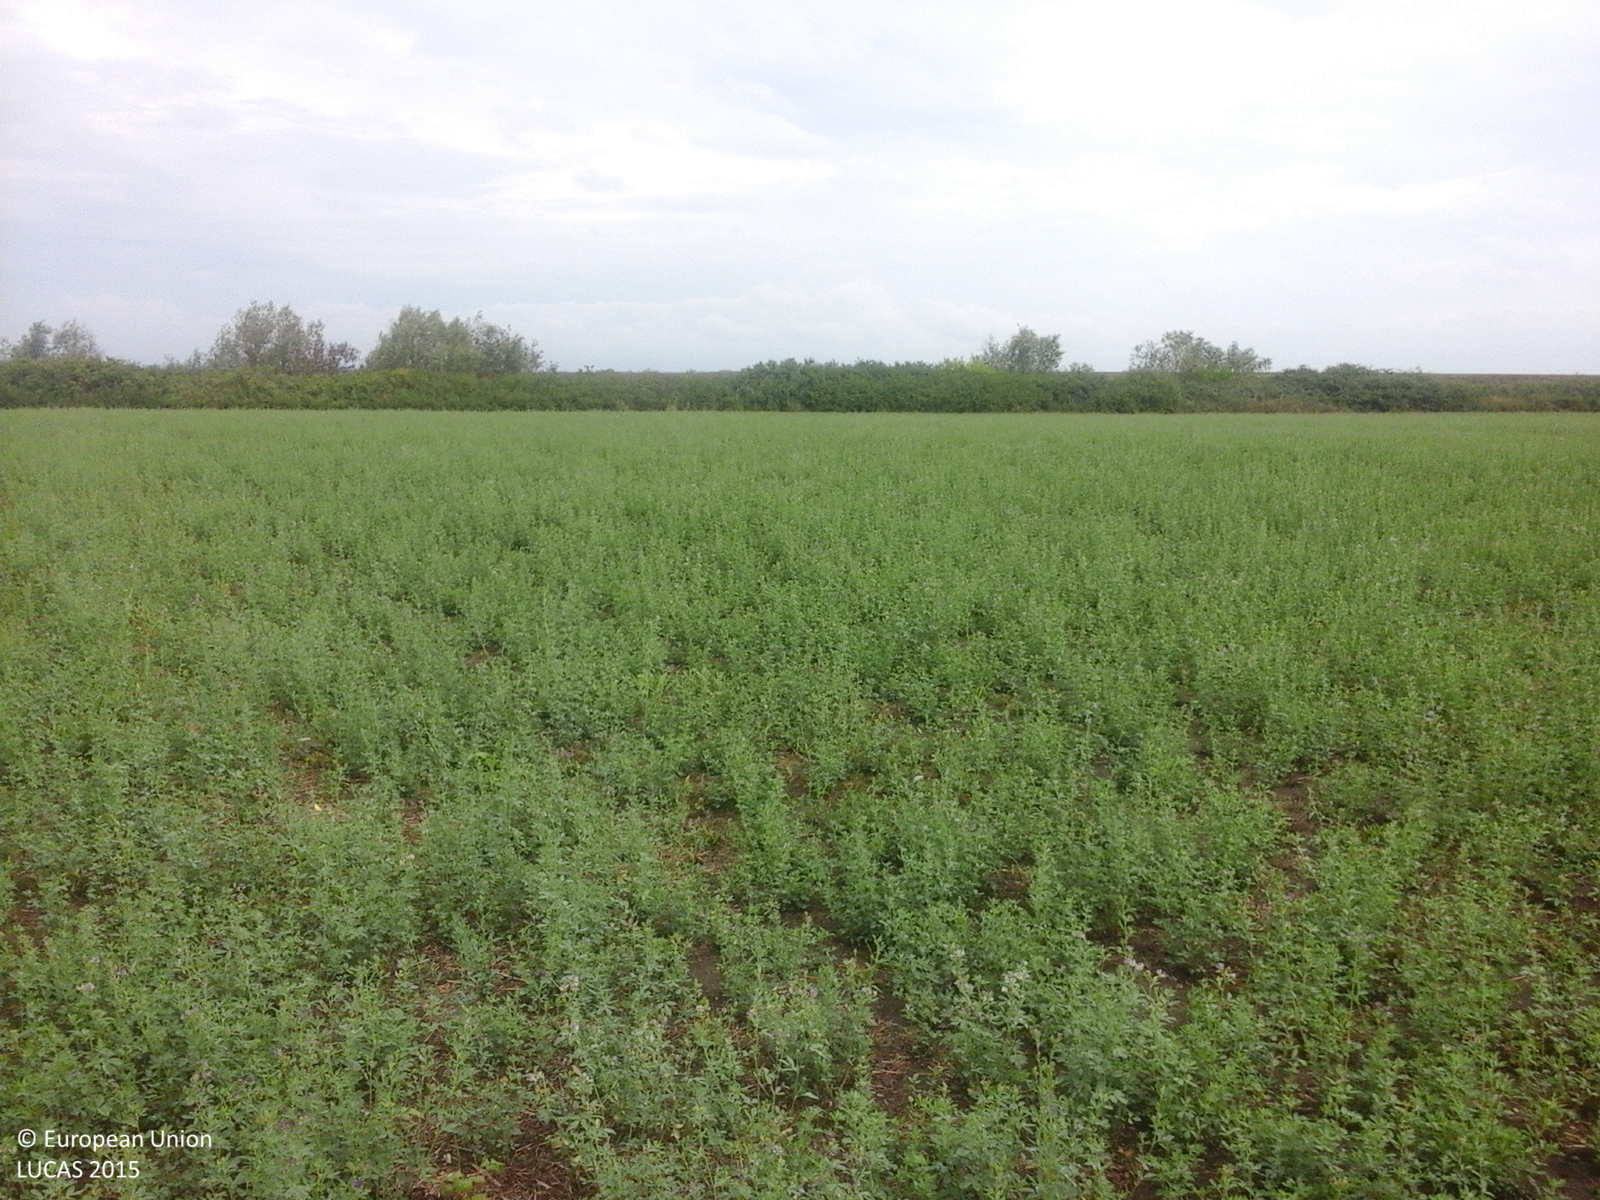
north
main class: Cropland
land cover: Lucerne
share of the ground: > 75 %
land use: Agriculture (excluding fallow land and kitchen gardens)
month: August
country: RO
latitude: 45.5364
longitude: 21.2605
